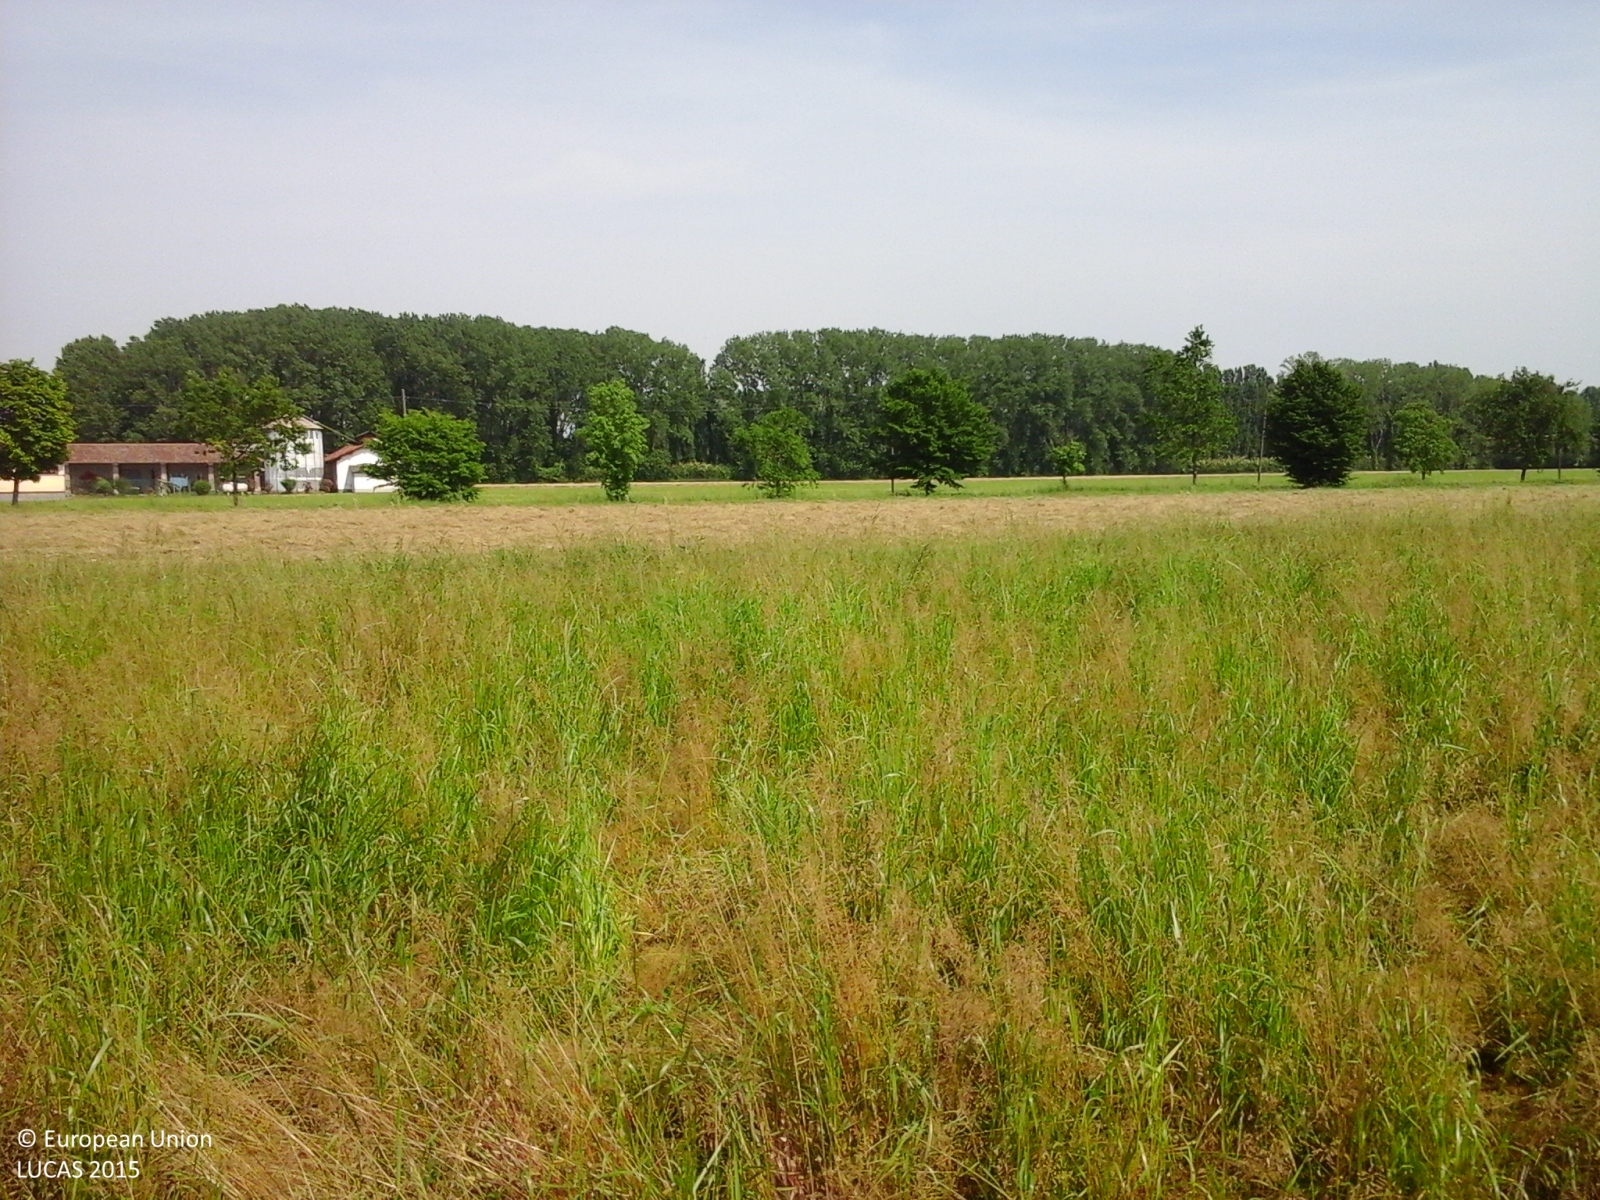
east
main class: Grassland
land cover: Spontaneously vegetated surfaces
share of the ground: > 75 %
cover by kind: herbaceous plants 100 %
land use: Agriculture (excluding fallow land and kitchen gardens)
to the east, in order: Spontaneously vegetated surfaces; Grass margins; Ditches and canals; Grass margins; Temporary grasslands; Grass margins; Ditches and canals; Managed hedges; Tracks; Grass margins; Ditches and canals; Grass margins; Temporary grasslands; Grass margins; Ditches and canals; Grass margins; Temporary grasslands
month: May
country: IT
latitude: 45.4485
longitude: 9.3746
